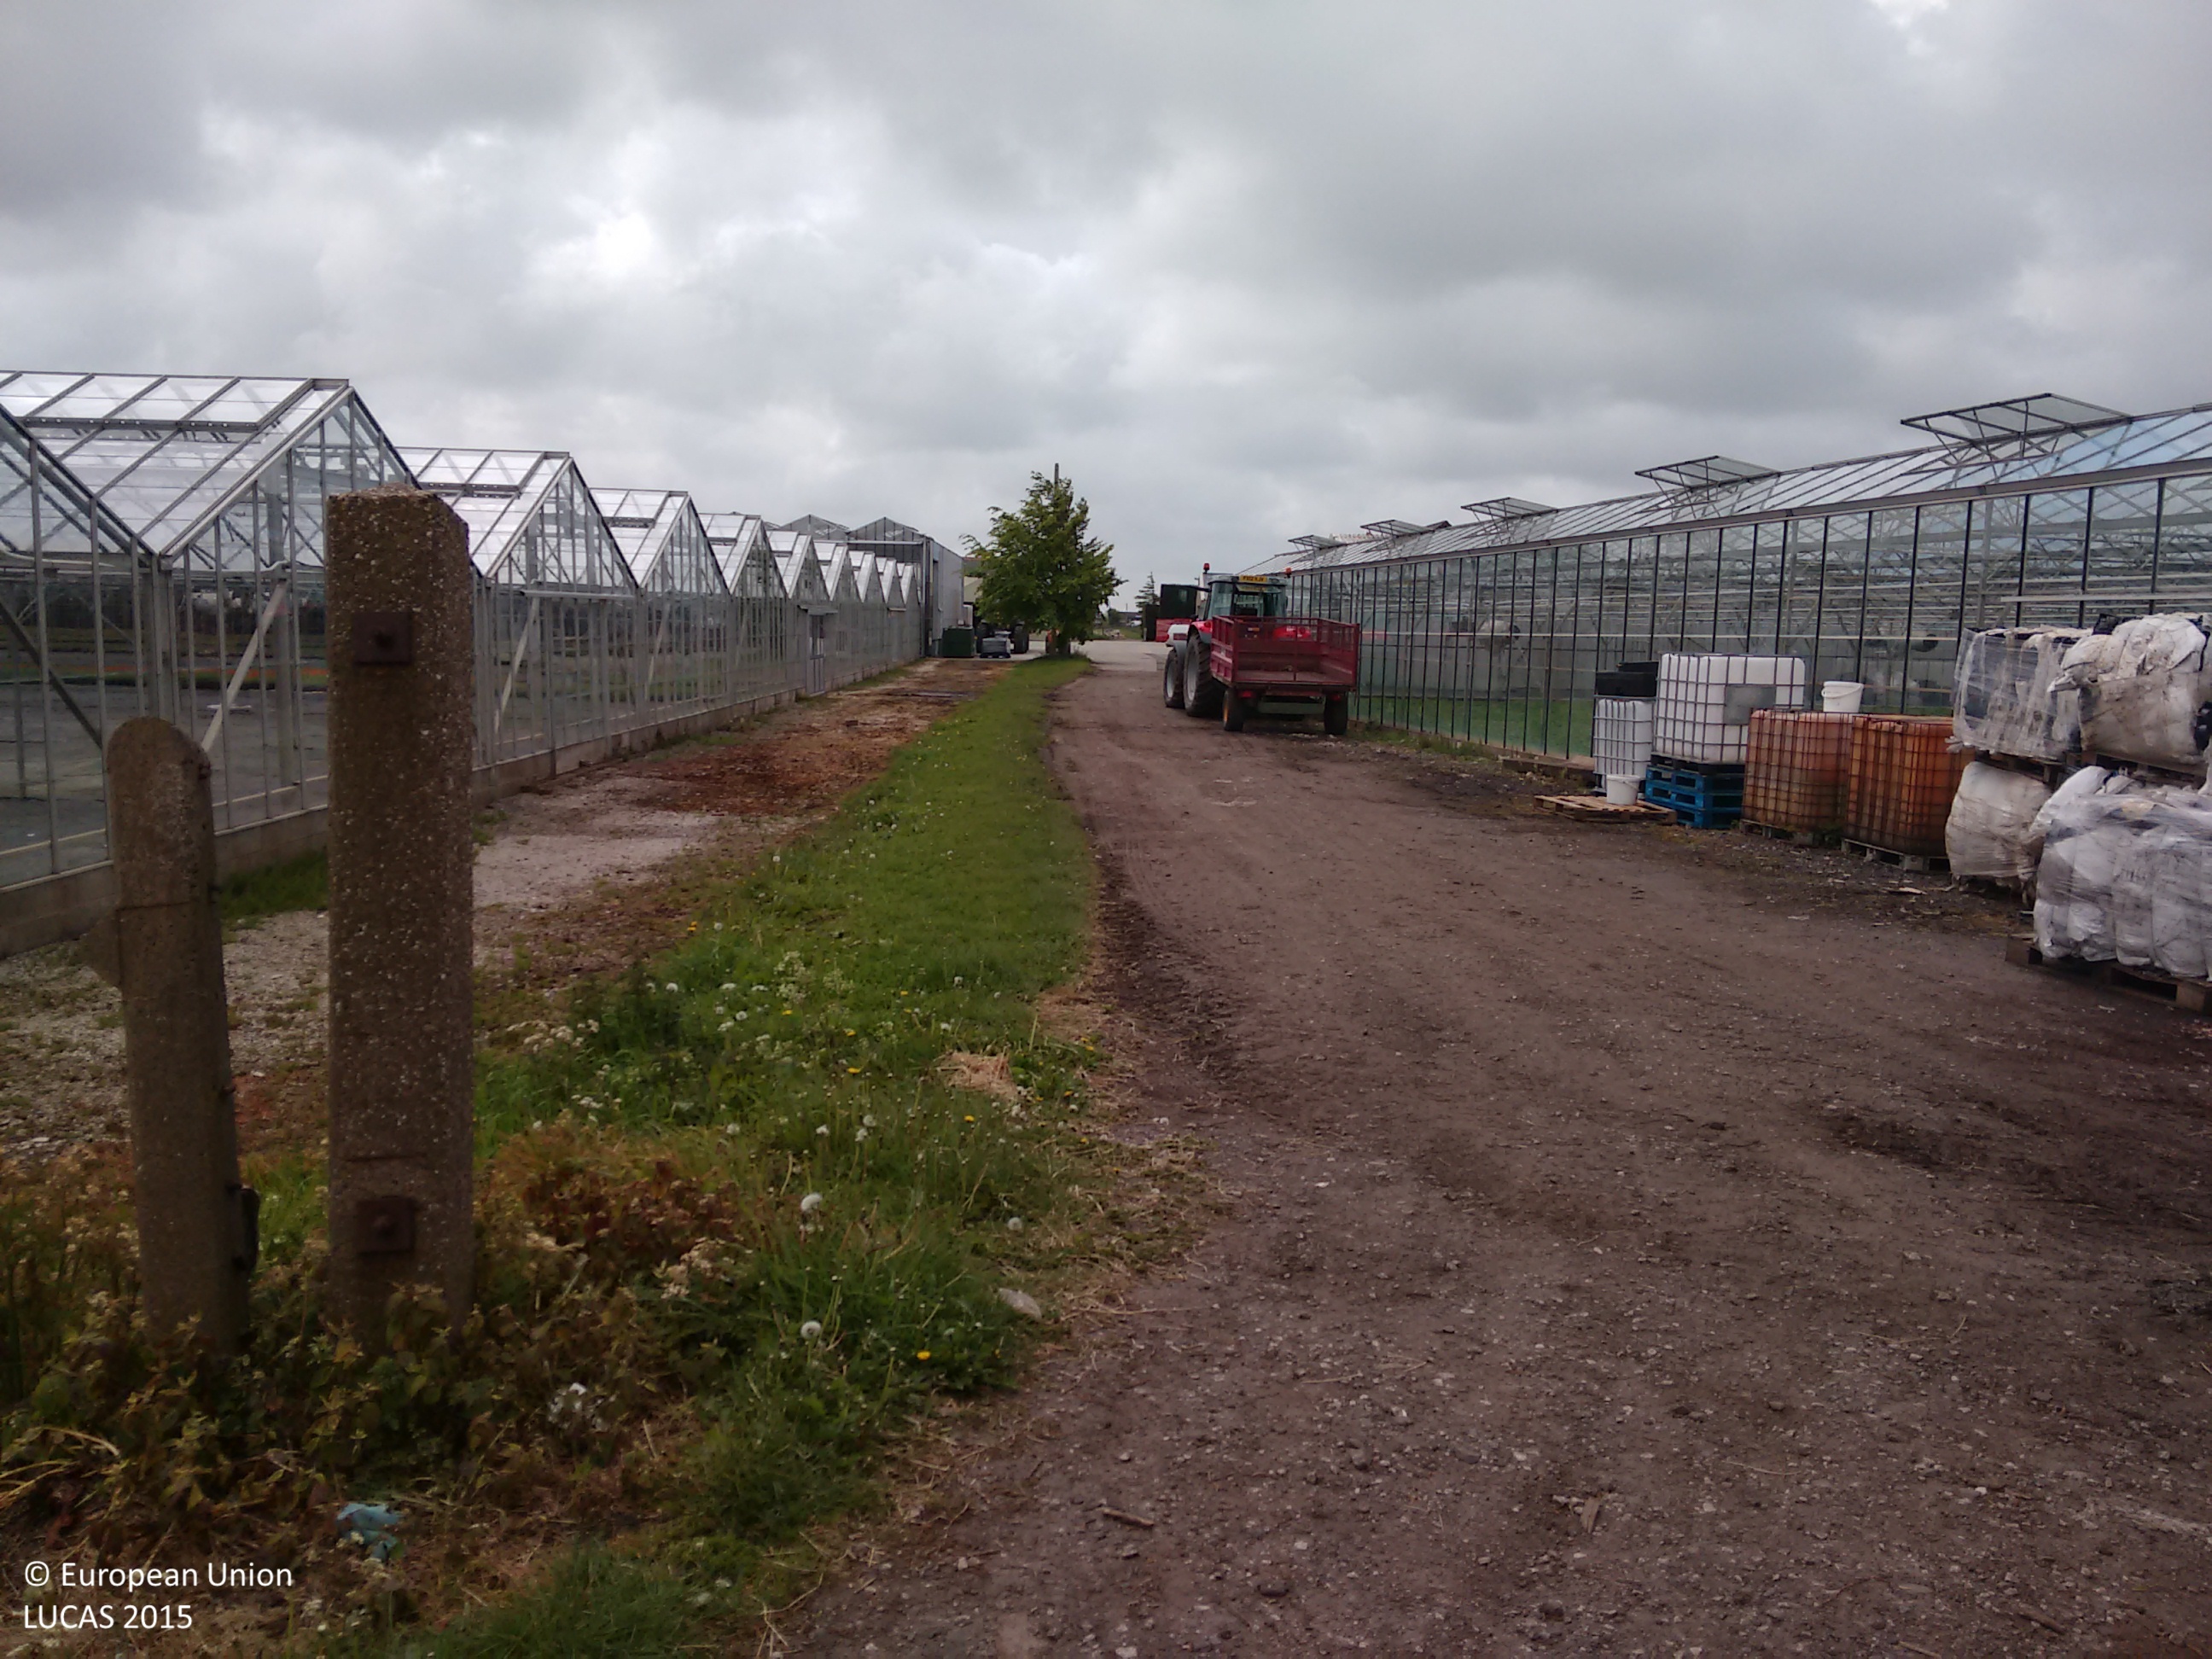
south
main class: Artificial land
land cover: Greenhouses
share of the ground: > 75 %
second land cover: Strawberries
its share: > 75 %
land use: Agriculture (excluding fallow land and kitchen gardens)
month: May
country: GB
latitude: 53.6954
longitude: -2.8693
